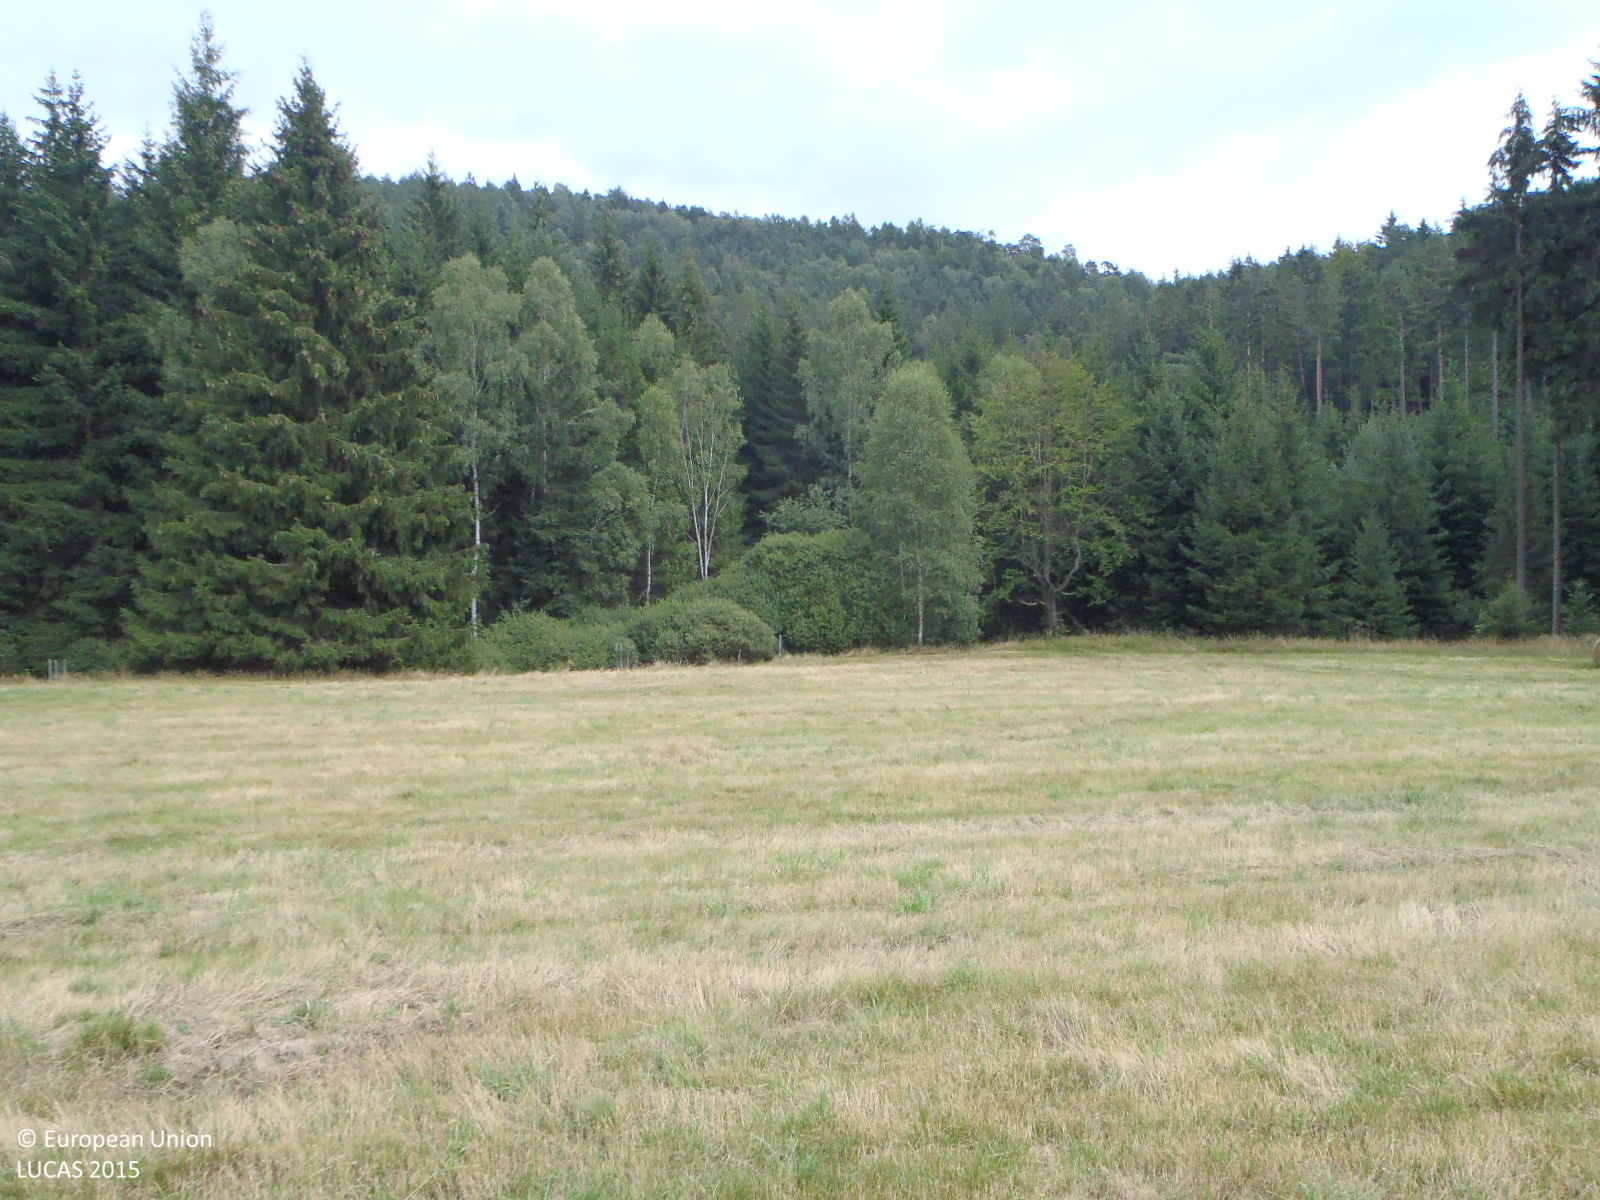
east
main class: Grassland
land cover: Grassland without tree/shrub cover
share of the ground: > 75 %
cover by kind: herbaceous plants 100 %
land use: Agriculture (excluding fallow land and kitchen gardens)
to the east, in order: Grassland without tree/shrub cover; Shrubland without tree cover; Broadleaved woodland; Spruce dominated mixed woodland; Tracks; Other coniferous woodland; Spruce dominated coniferous woodland; Spruce dominated mixed woodland; Other coniferous woodland
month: August
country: CZ
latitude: 50.8079
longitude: 14.6995
